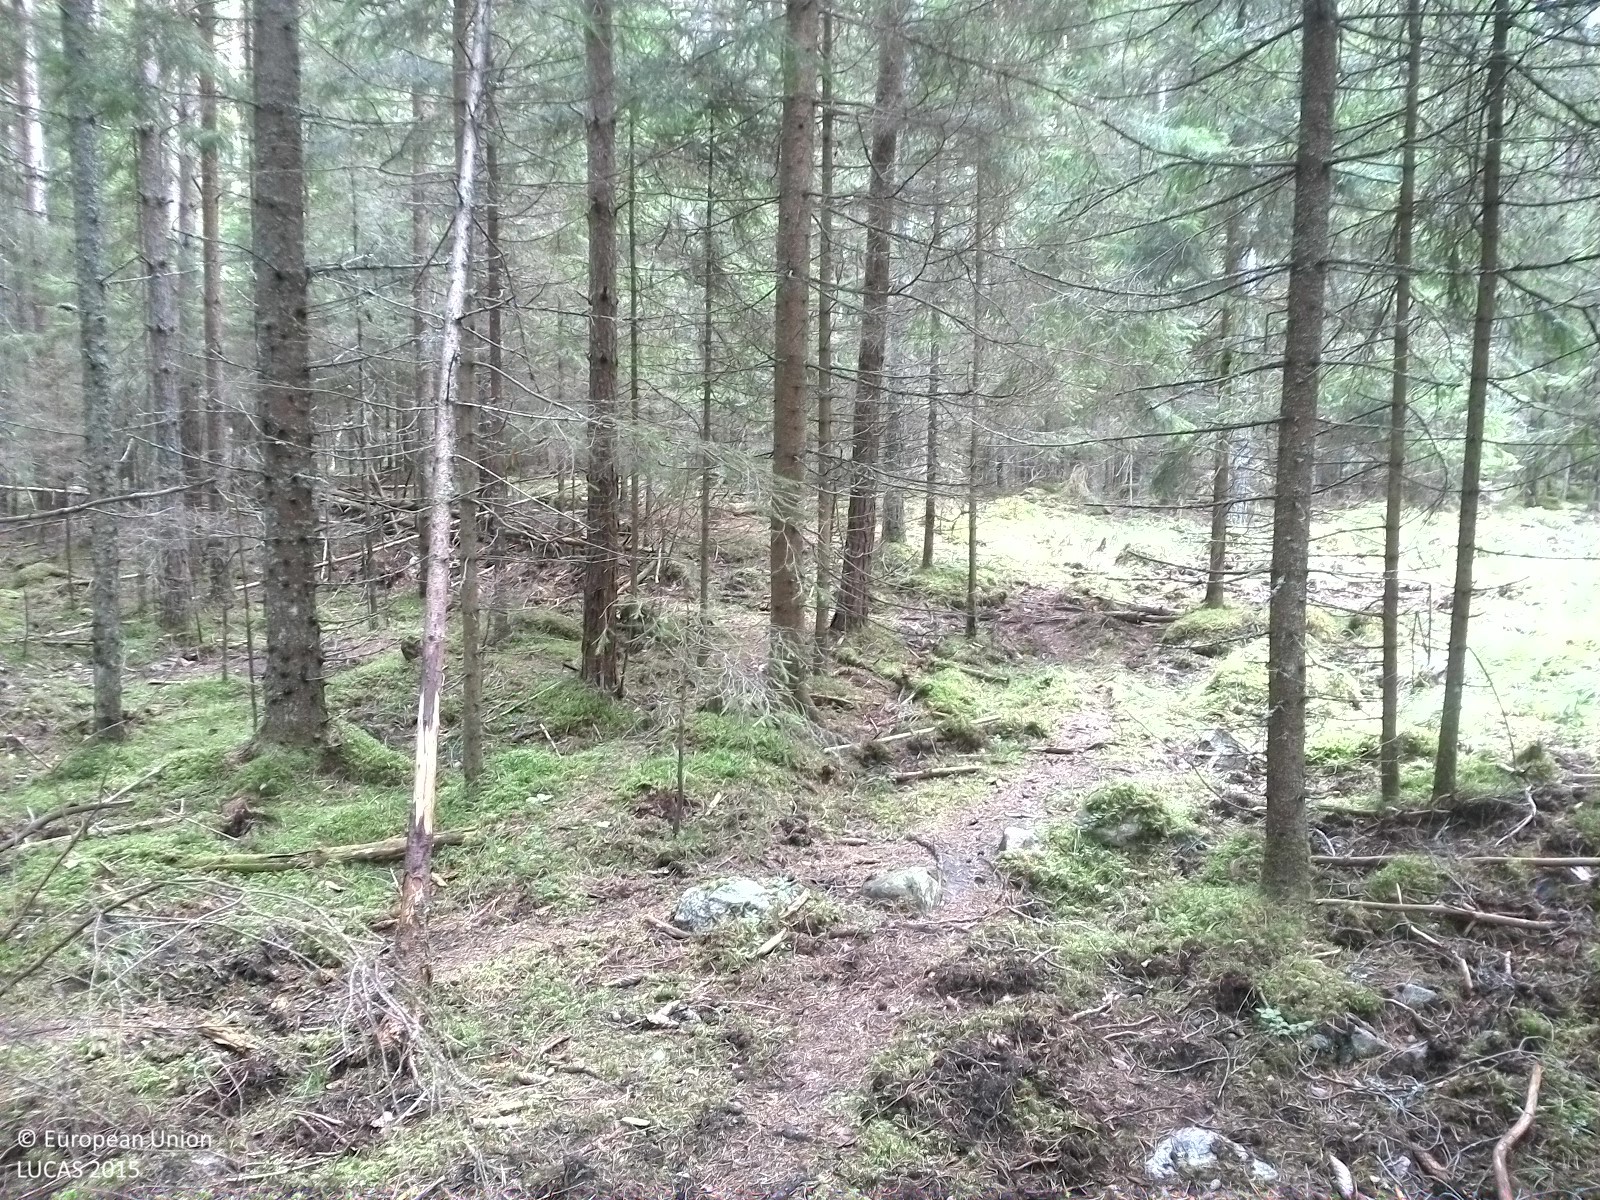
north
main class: Woodland
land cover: Spruce dominated coniferous woodland
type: boreal forest
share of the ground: 50 - 75 %
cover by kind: coniferous forest trees 60 %, lichens and mosses 30 %, herbaceous plants 5 %, unconsolidated bare surface 5 %
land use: Forestry
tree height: > 5 m
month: August
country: SE
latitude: 58.7876
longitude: 15.6163
